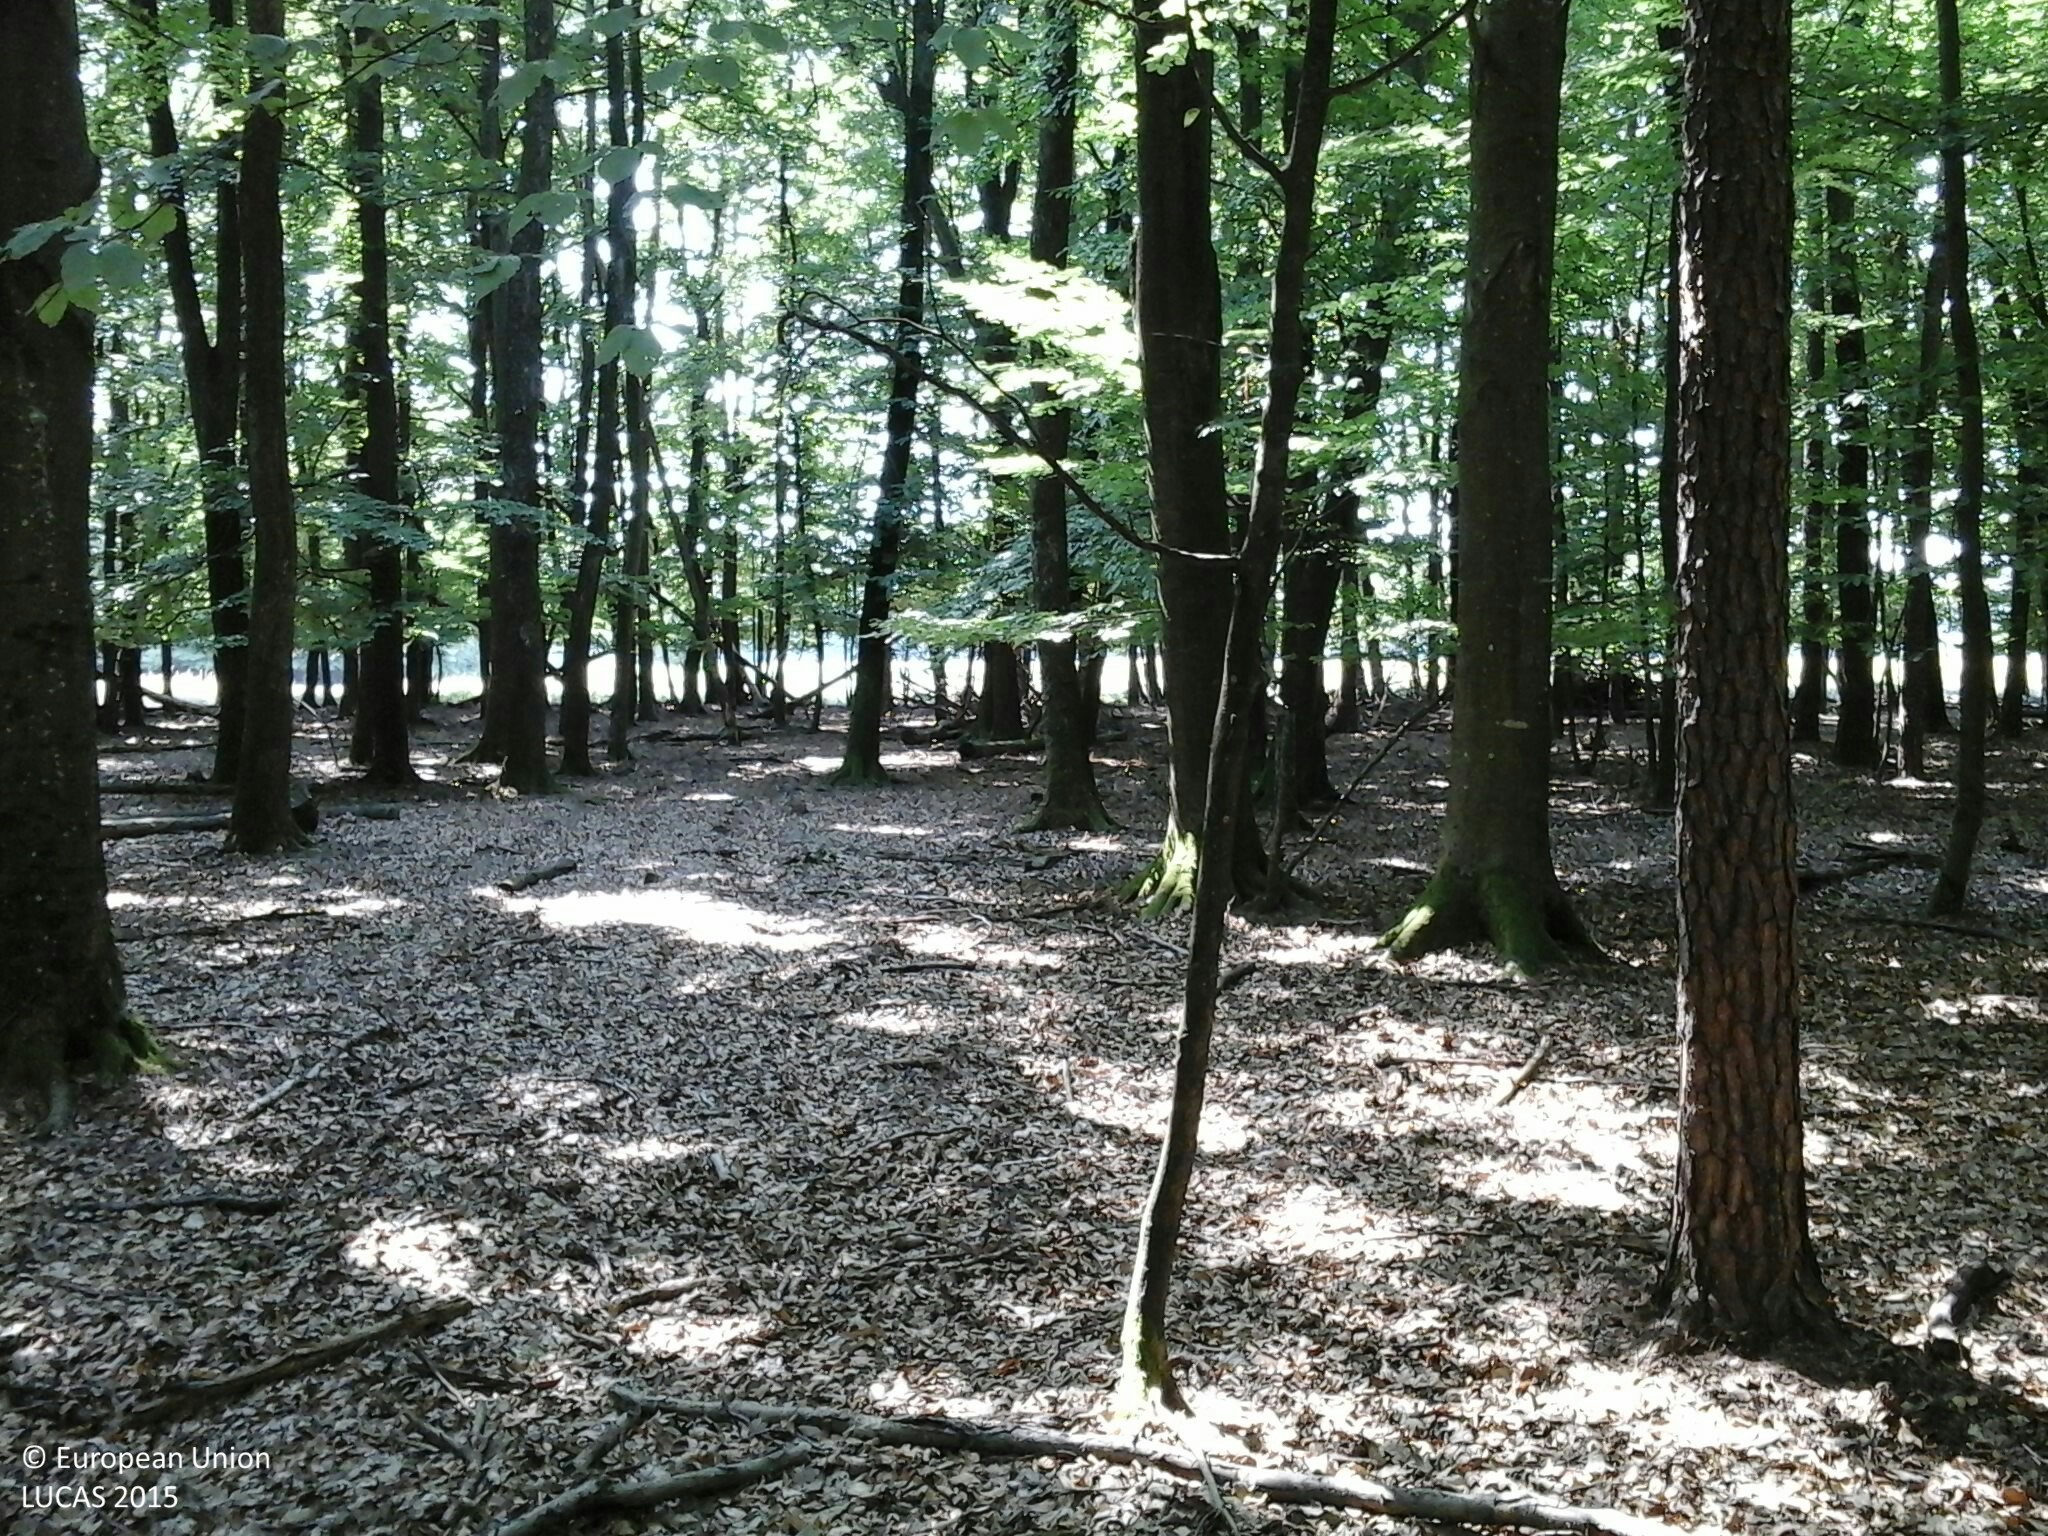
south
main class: Woodland
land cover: Broadleaved woodland
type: mesophytic deciduous forest
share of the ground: > 75 %
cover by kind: broadleaved forest trees 90 %, coniferous forest trees 10 %
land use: Forestry
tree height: > 5 m
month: July
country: HU
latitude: 46.6711
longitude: 16.6029
